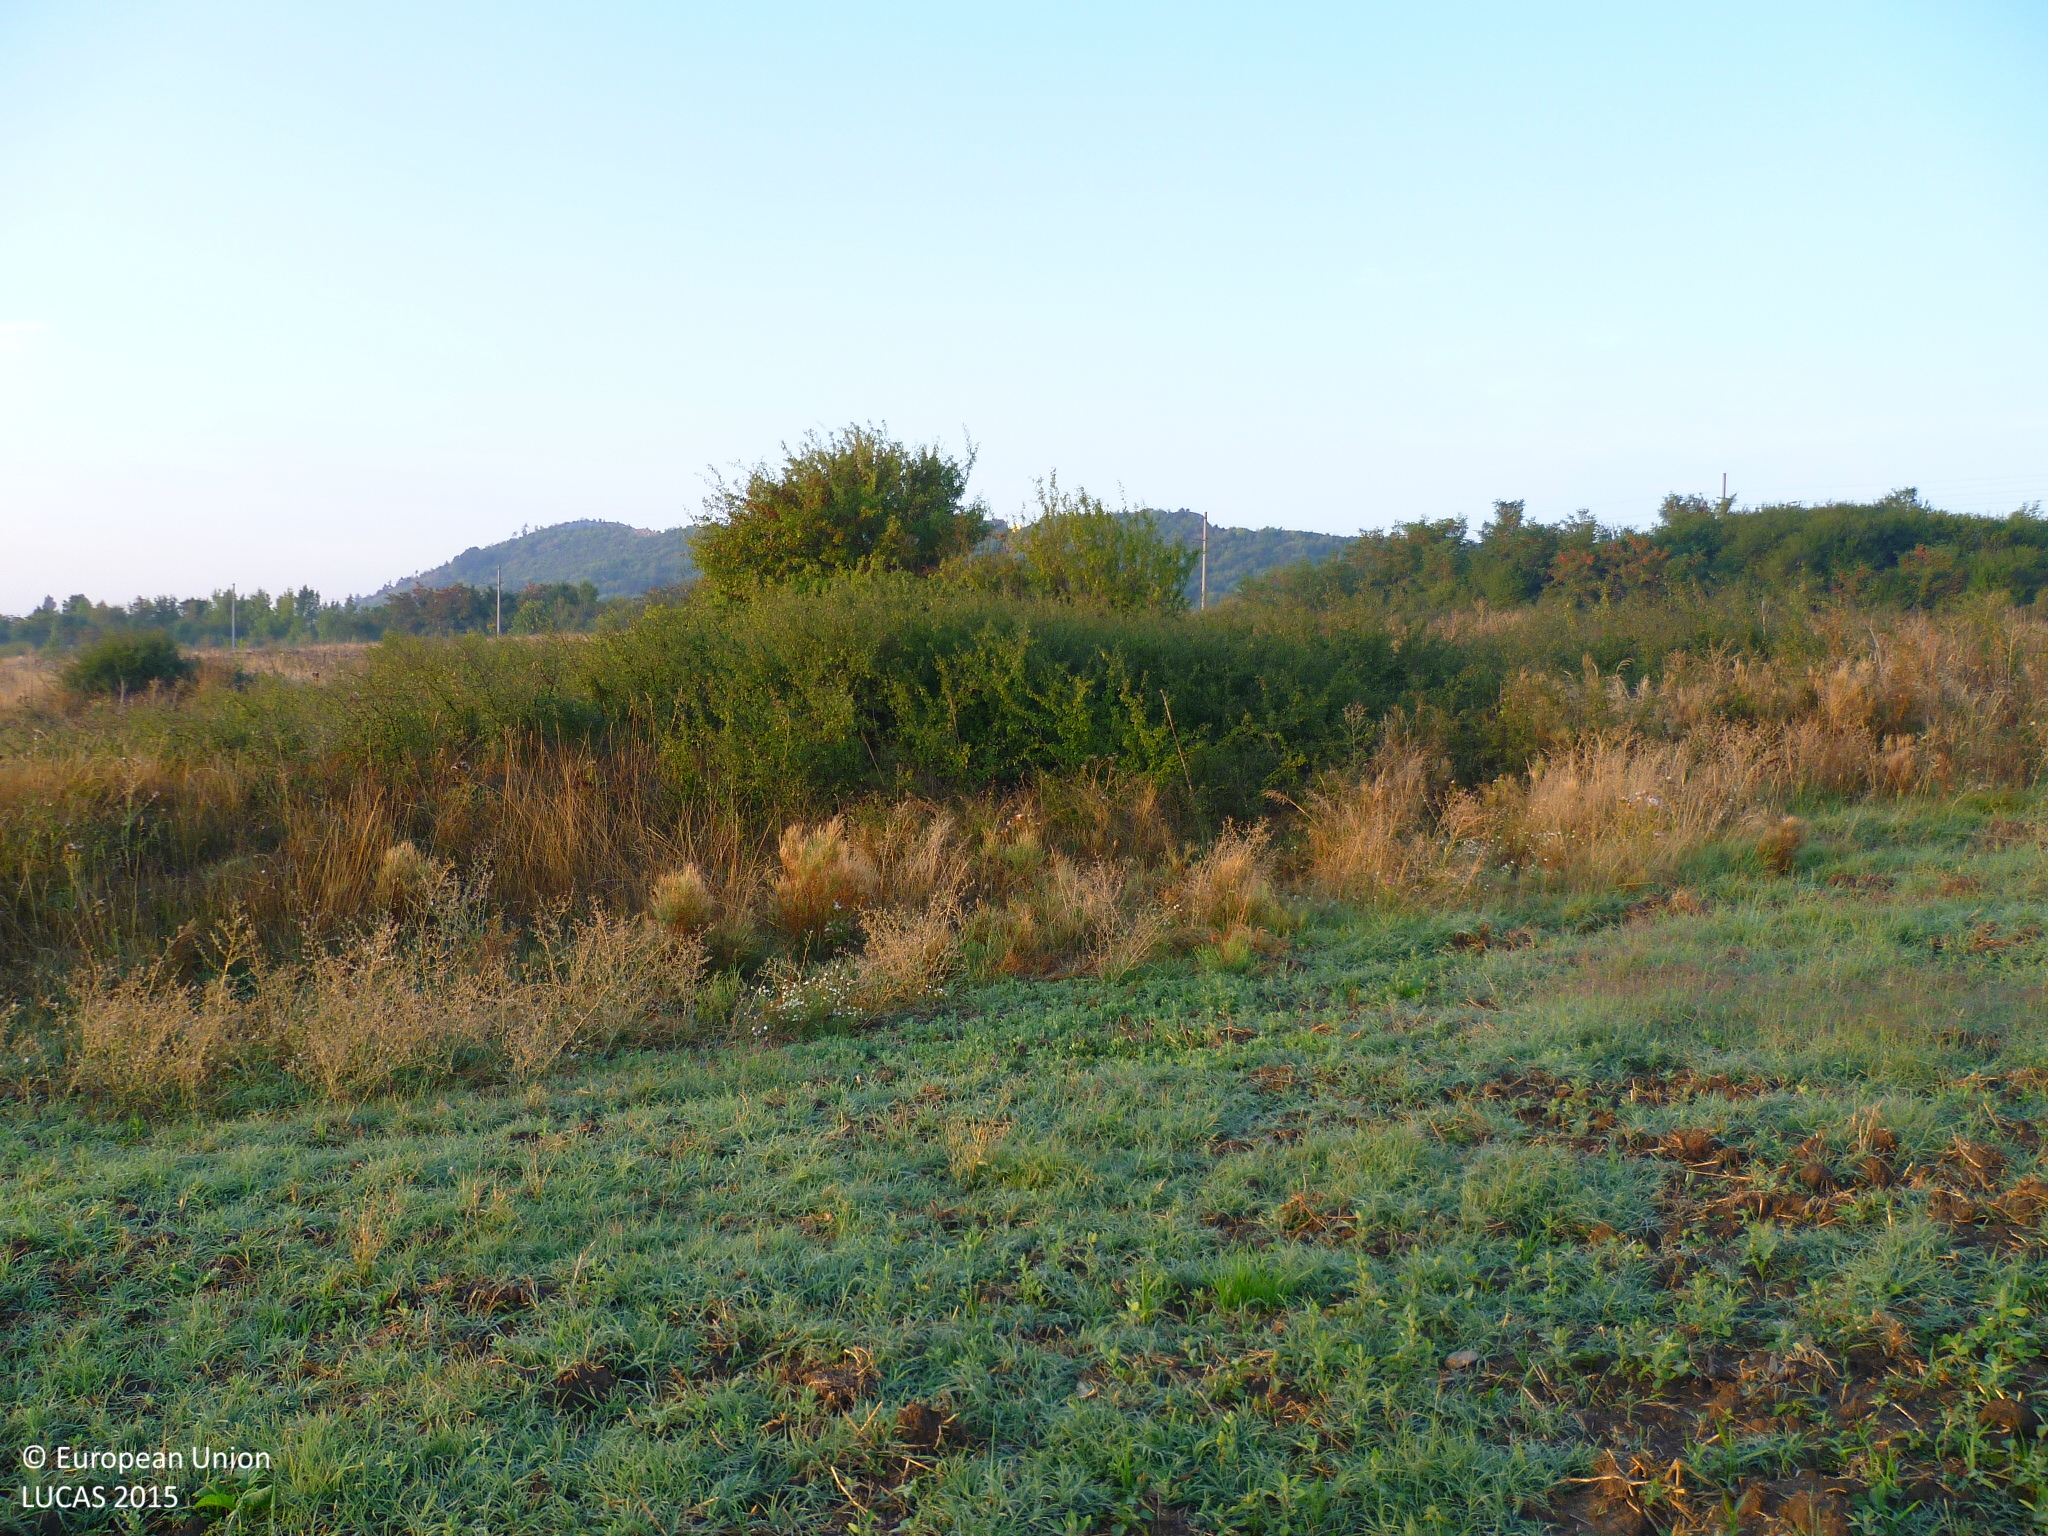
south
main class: Cropland
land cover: Rye
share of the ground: < 10 %
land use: Agriculture (excluding fallow land and kitchen gardens)
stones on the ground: < 10 %
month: September
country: BG
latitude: 42.8692
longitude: 23.0191
